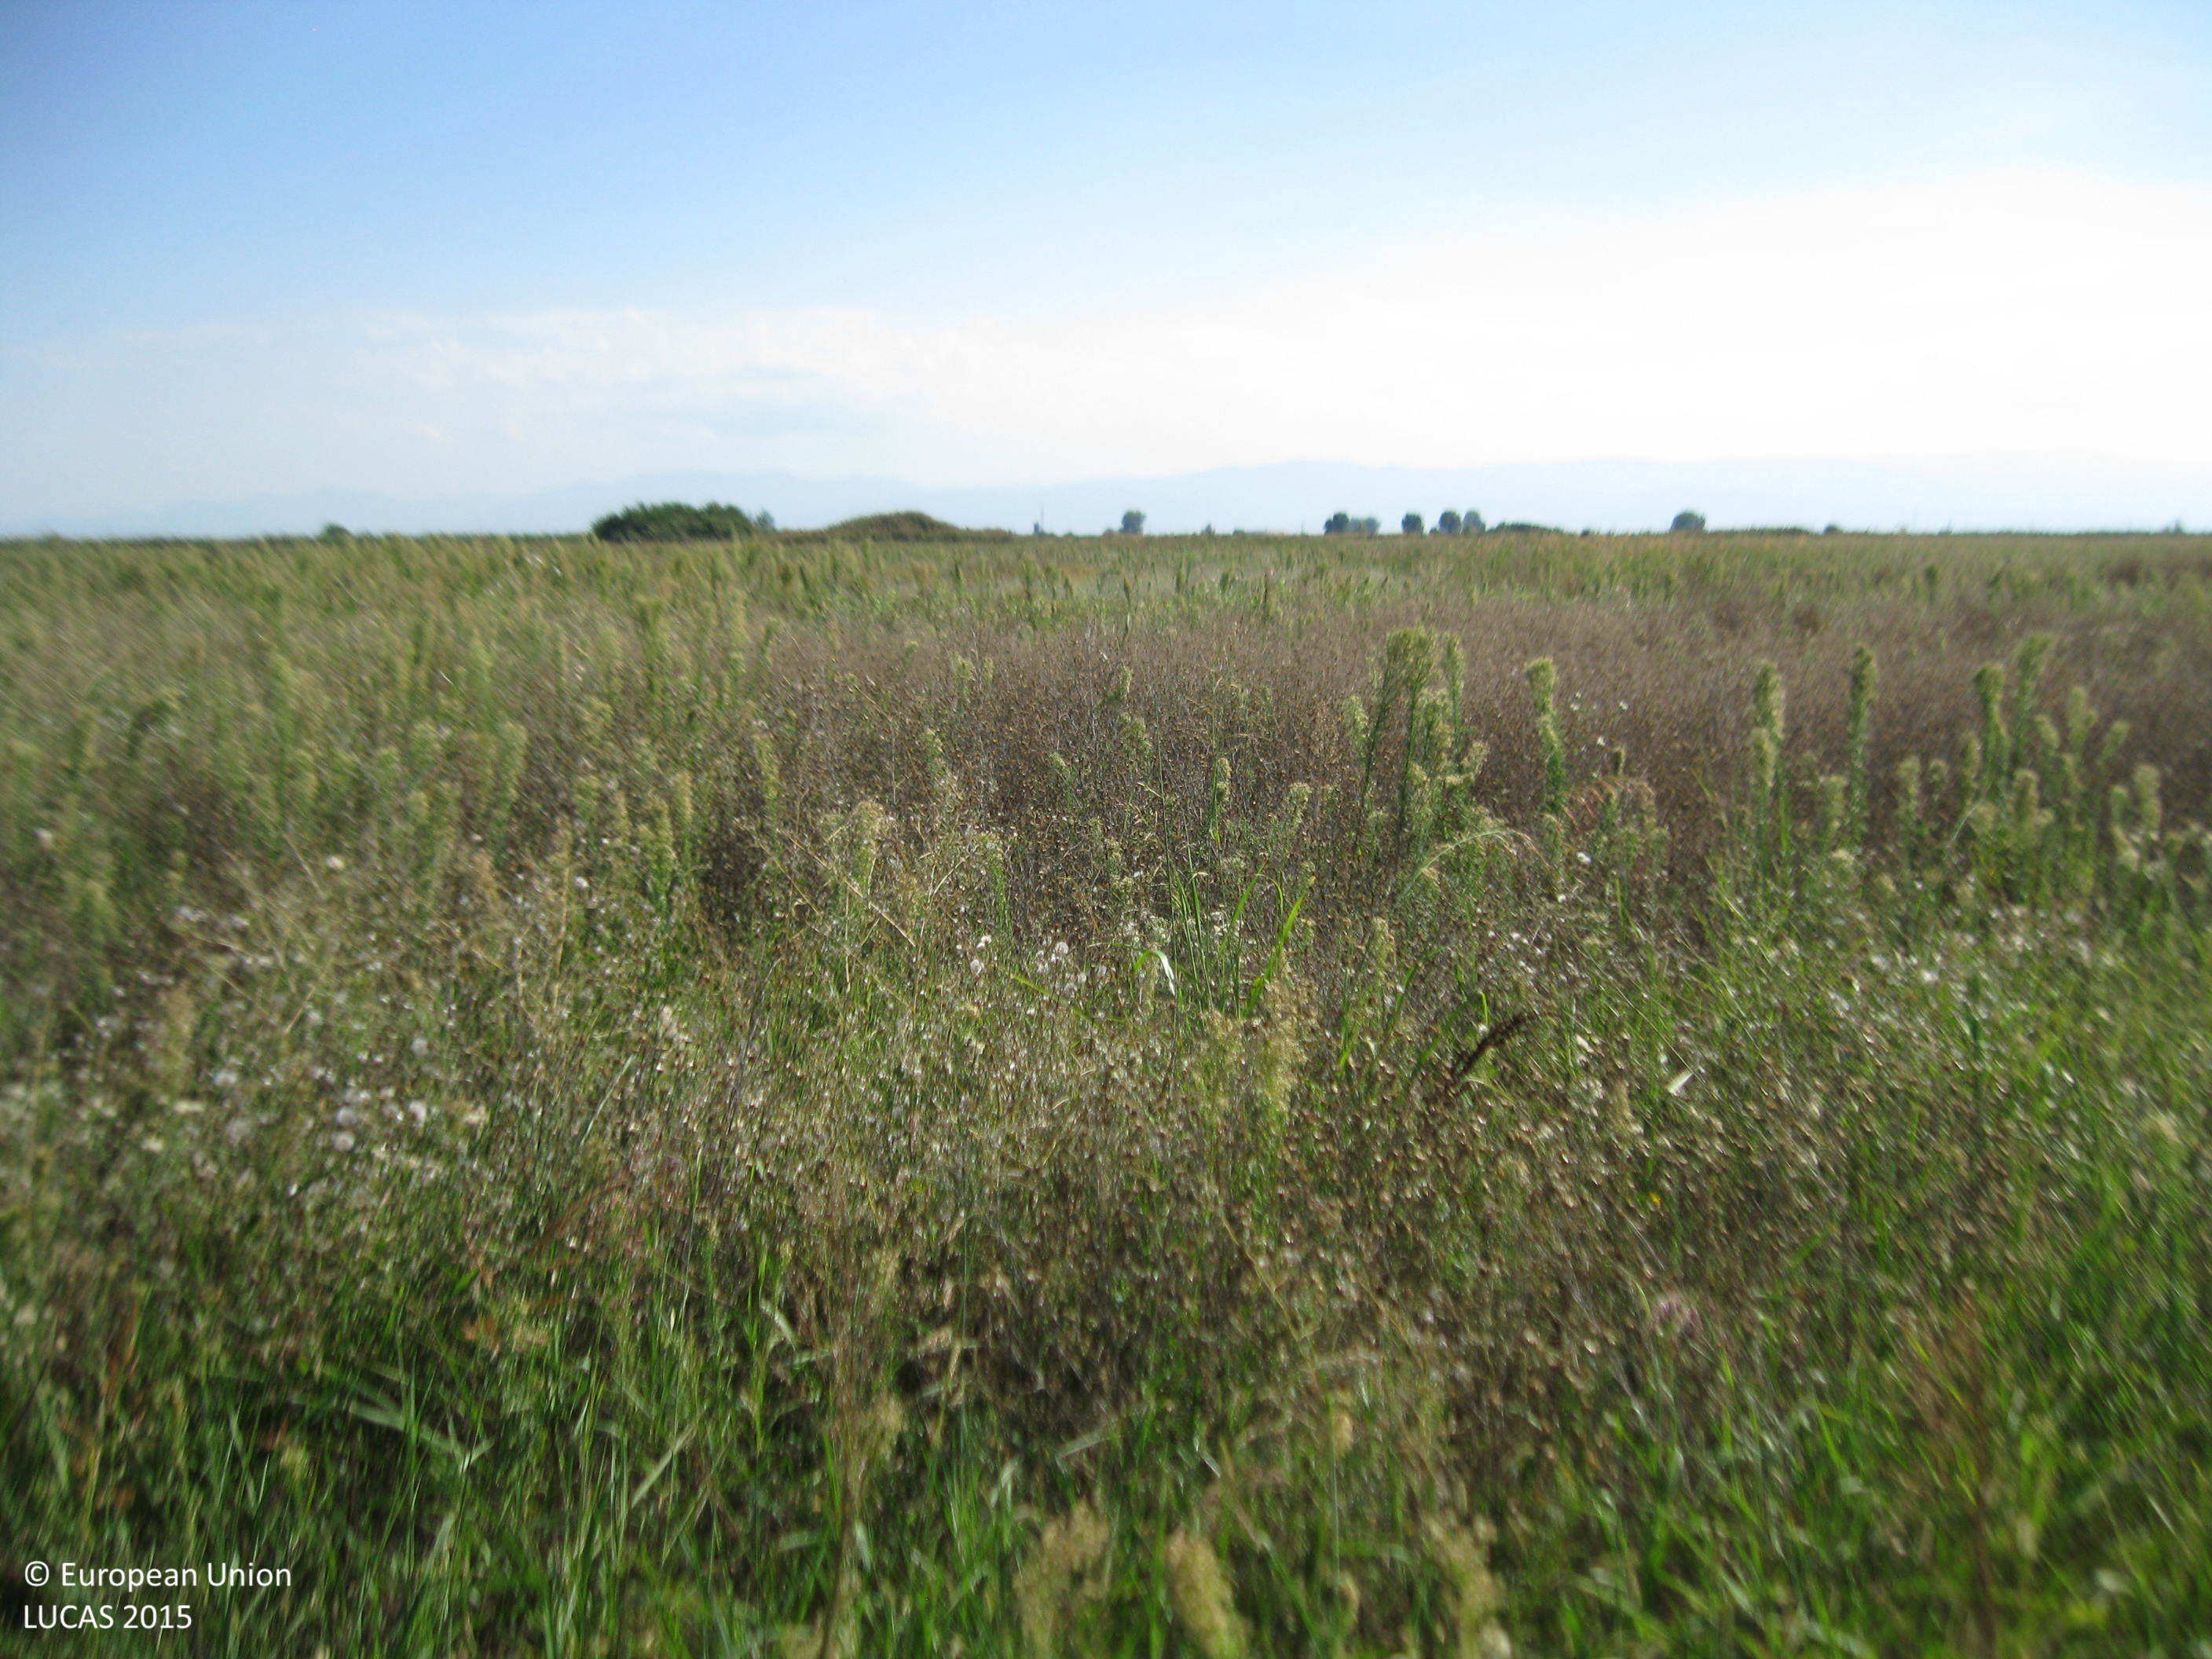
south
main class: Grassland
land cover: Spontaneously vegetated surfaces
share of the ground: > 75 %
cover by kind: herbaceous plants 100 %
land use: Fallow land
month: September
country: BG
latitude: 42.2944
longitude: 24.7905
